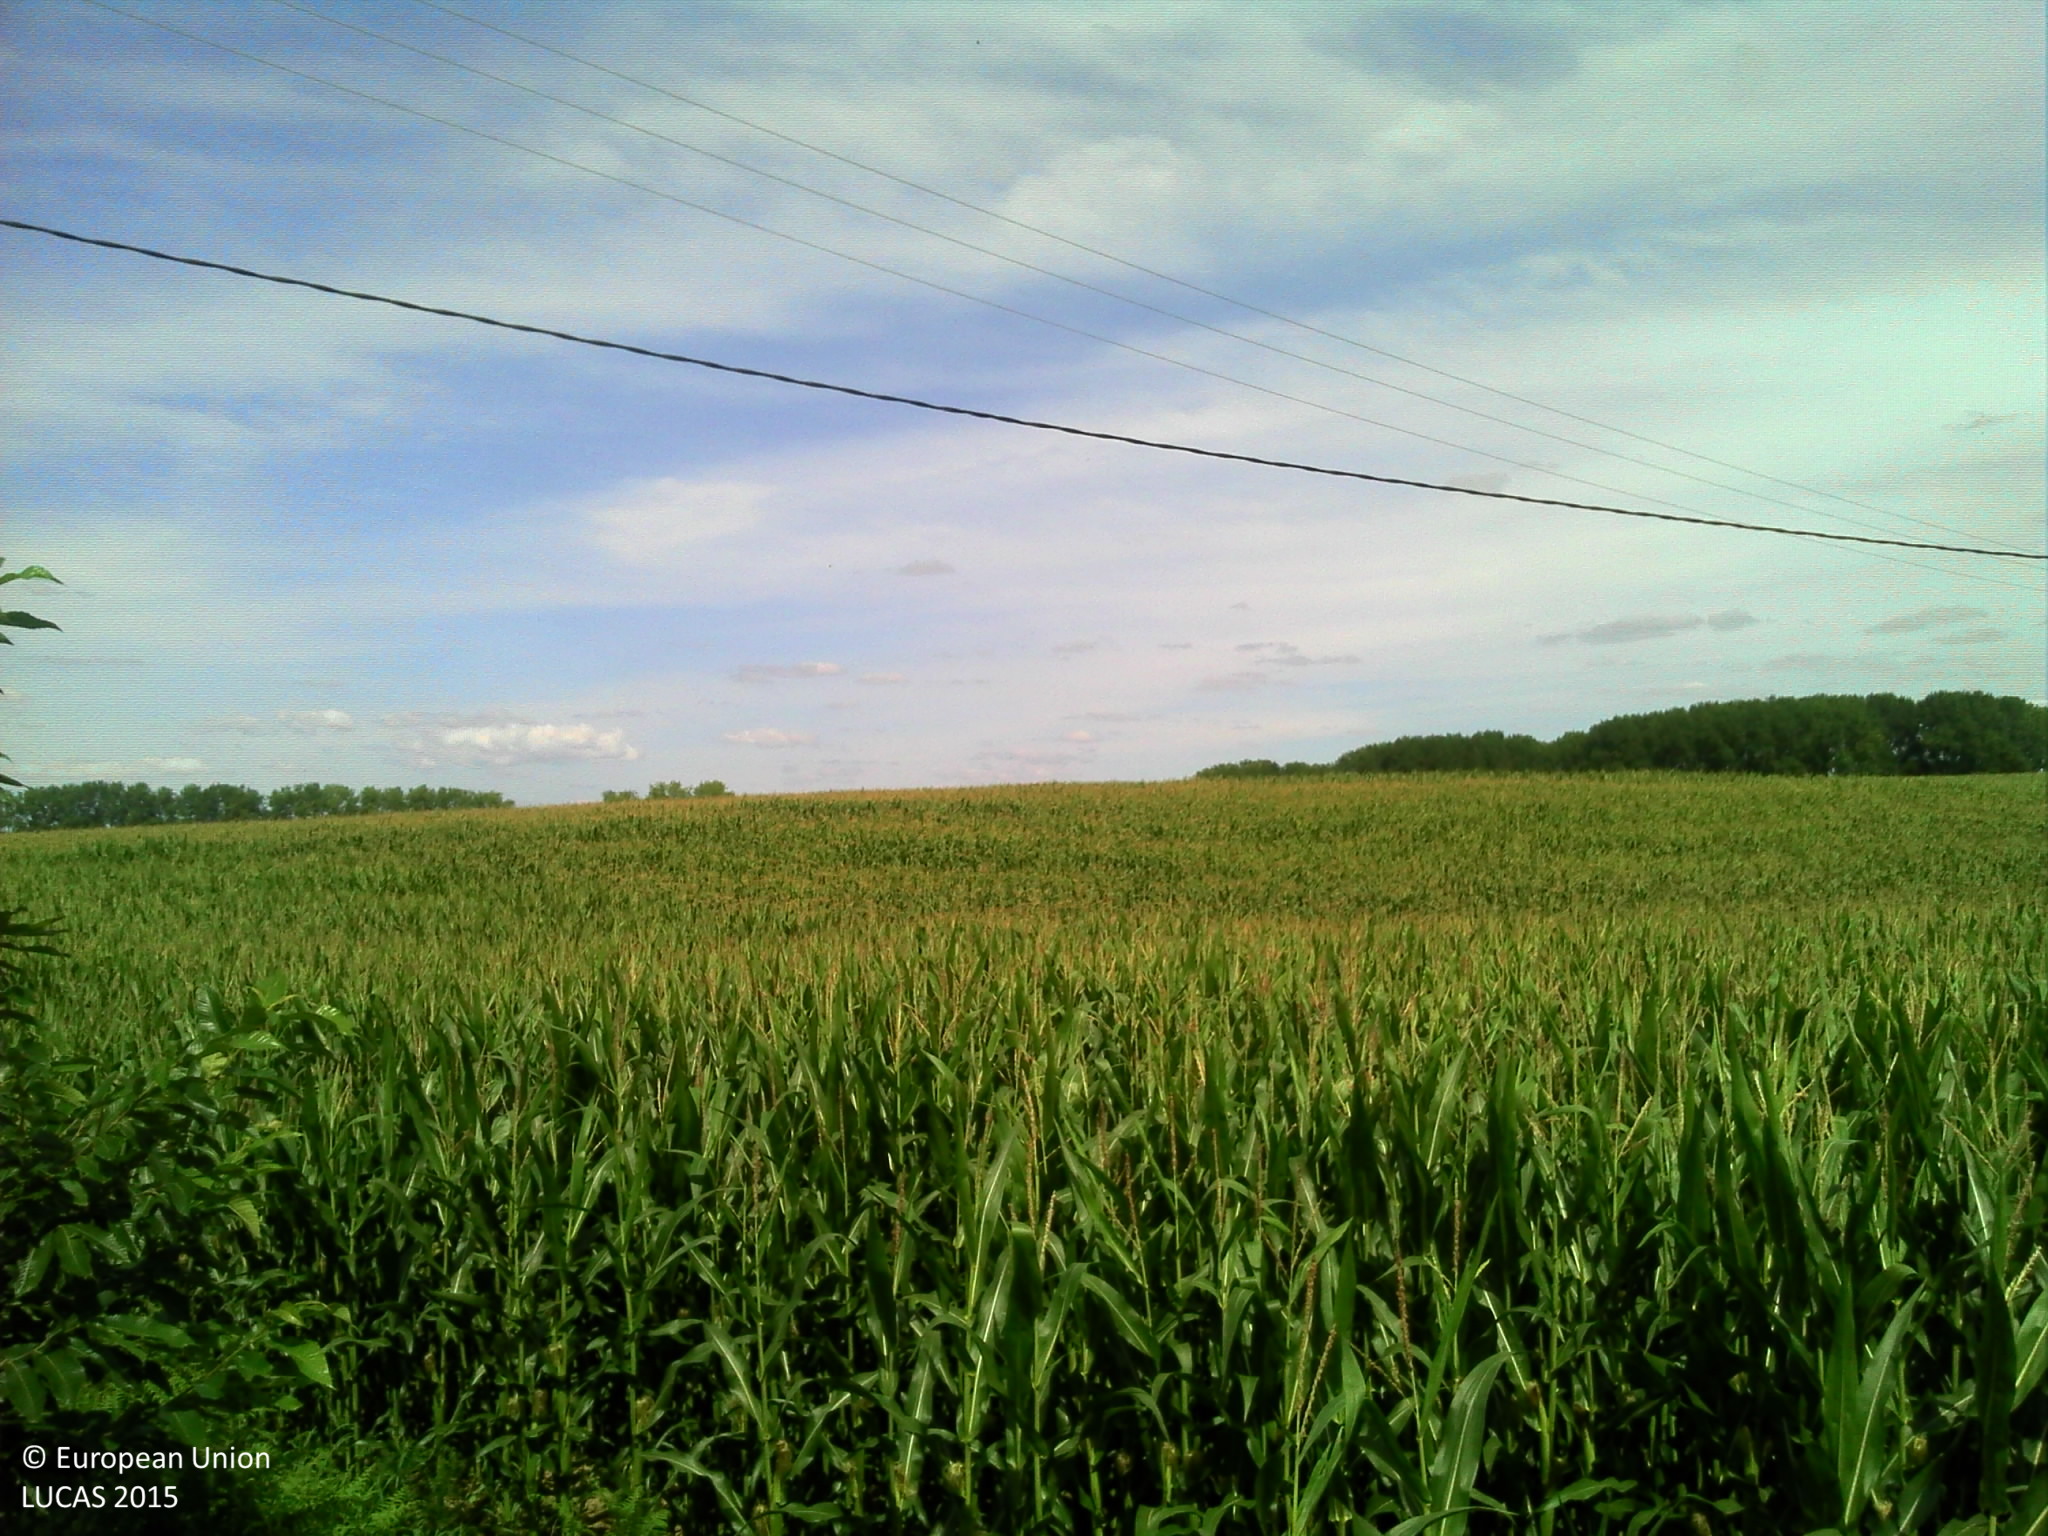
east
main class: Cropland
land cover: Maize
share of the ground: > 75 %
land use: Agriculture (excluding fallow land and kitchen gardens)
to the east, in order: Maize; Durum wheat
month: July
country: FR
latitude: 47.9996
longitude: -2.9739
